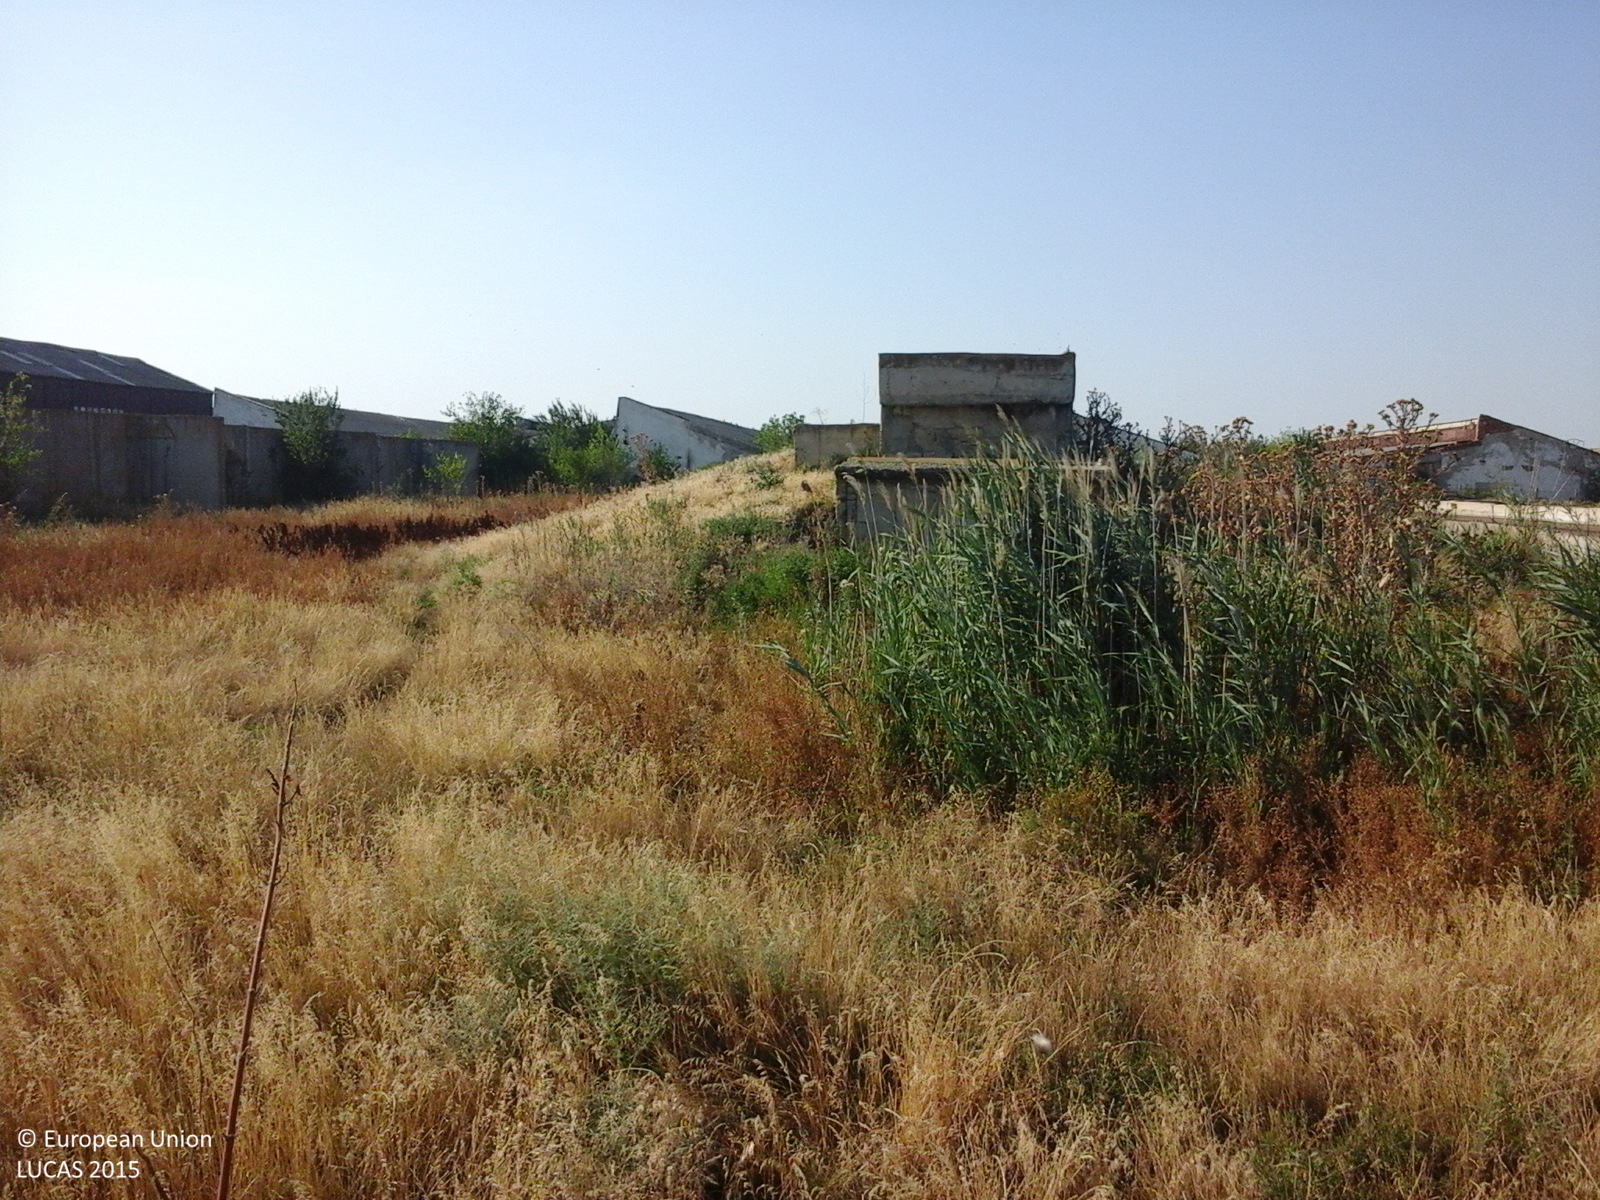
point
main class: Grassland
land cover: Spontaneously vegetated surfaces
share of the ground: > 75 %
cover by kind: herbaceous plants 100 %
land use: Agriculture (excluding fallow land and kitchen gardens)
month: July
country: RO
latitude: 44.9702
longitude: 27.3756
